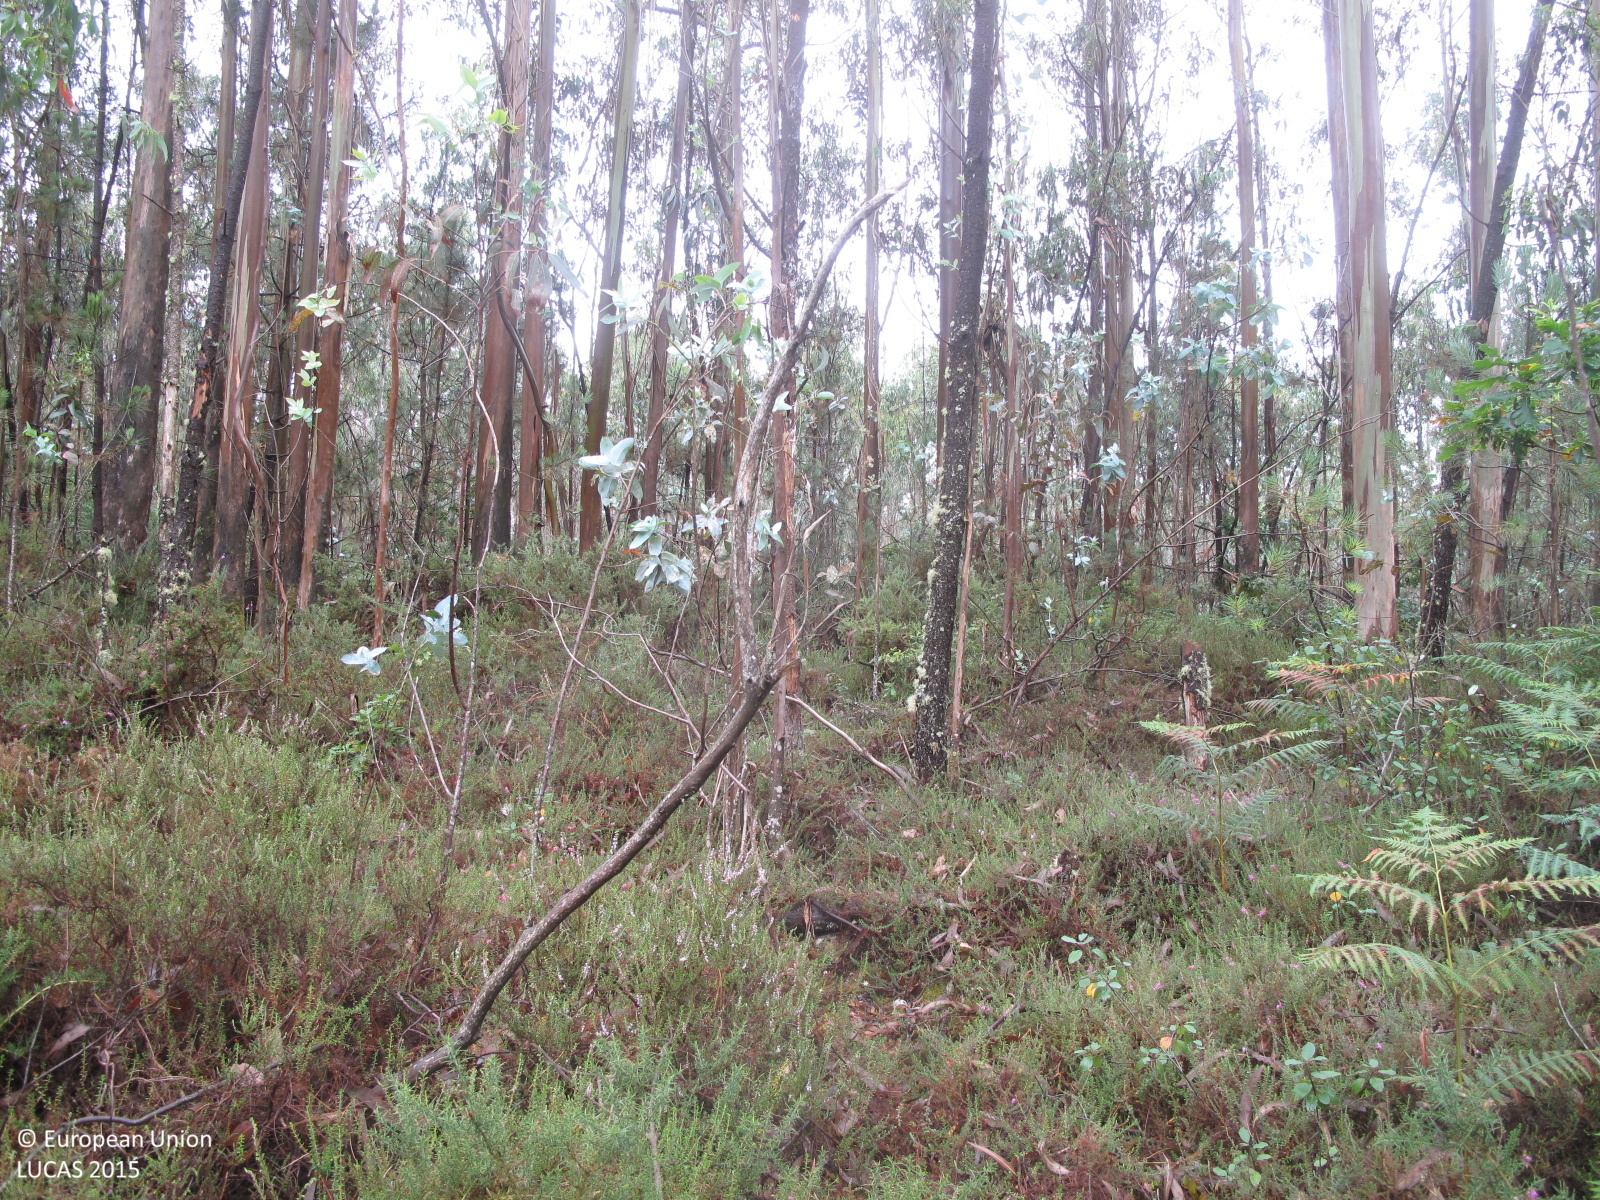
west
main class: Woodland
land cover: Pine dominated mixed woodland
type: hemiboreal forest and nemoral coniferous forest and mixed broadleaved-coniferous forest
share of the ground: 50 - 75 %
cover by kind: coniferous forest trees 40 %, broadleaved forest trees 30 %, shrubs 20 %, herbaceous plants 10 %
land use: Forestry
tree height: > 5 m
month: July
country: ES
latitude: 43.0646
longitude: -9.1481
